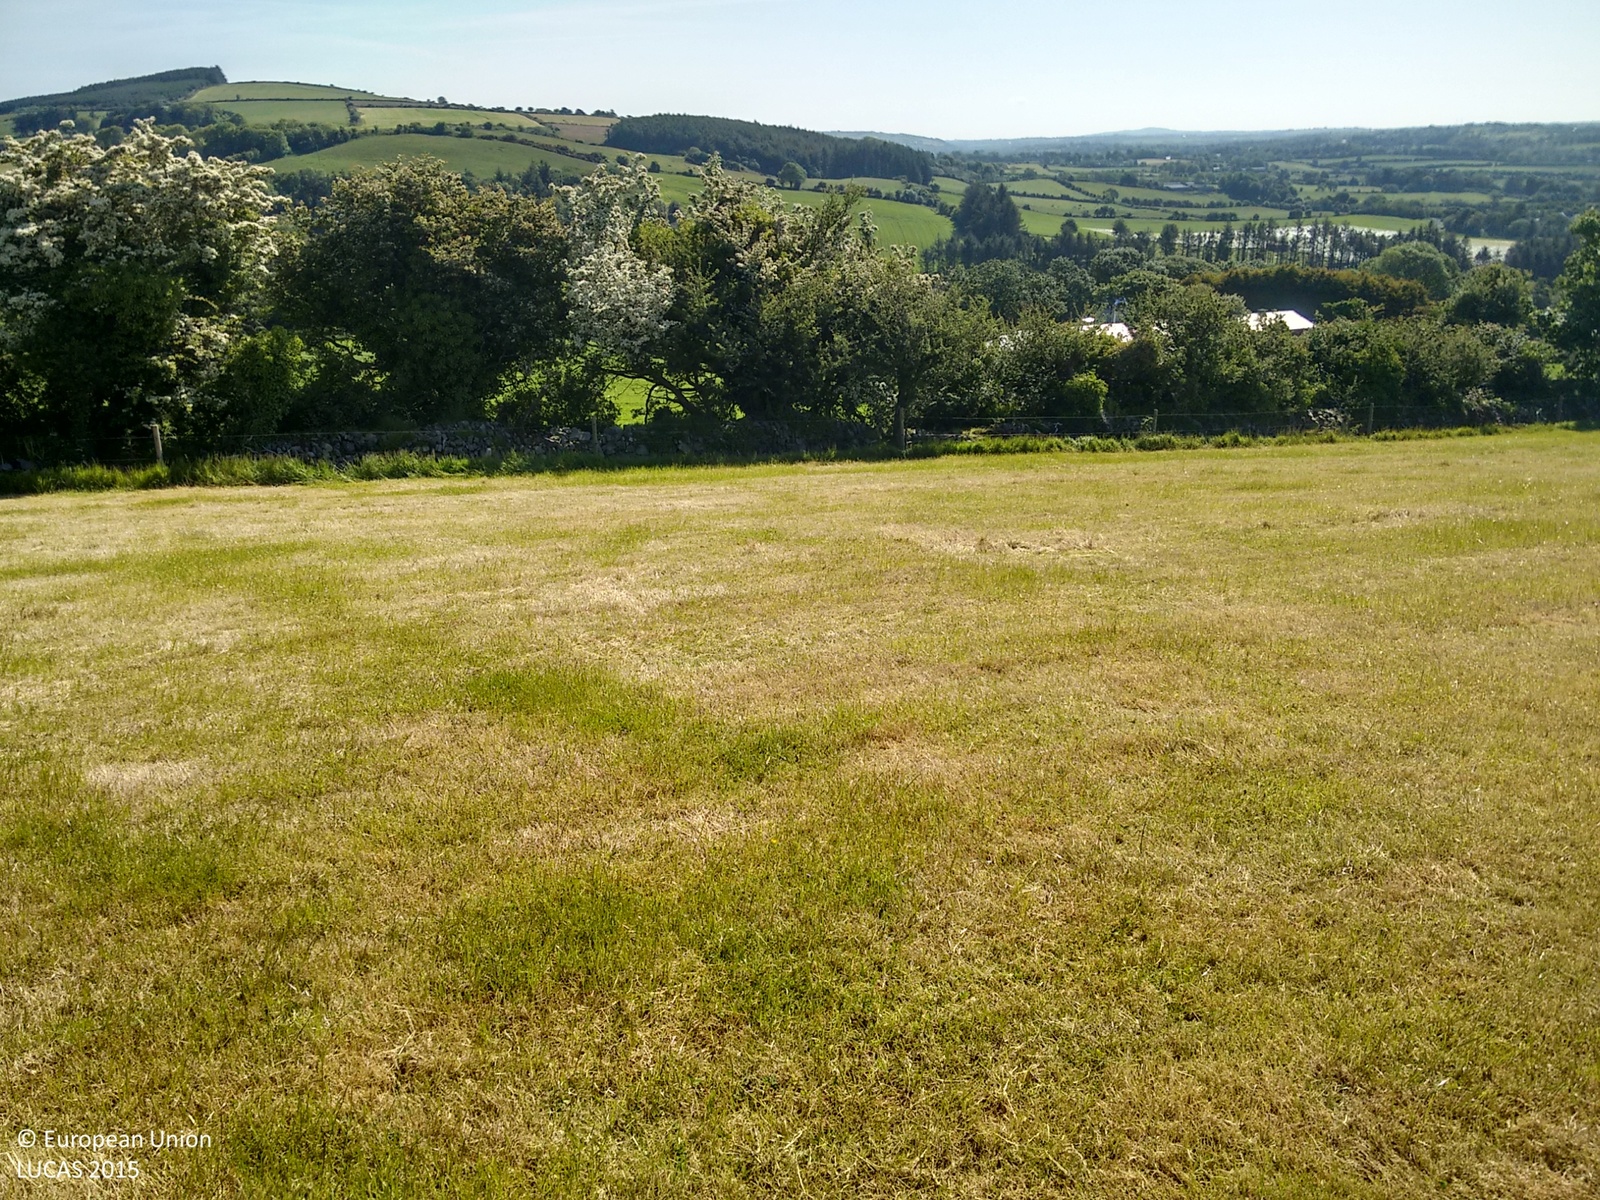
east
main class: Grassland
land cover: Grassland without tree/shrub cover
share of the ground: > 75 %
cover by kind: herbaceous plants 100 %
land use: Agriculture (excluding fallow land and kitchen gardens)
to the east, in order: Grassland without tree/shrub cover; Fences; Broadleaved woodland; Dry stone walls; Grass margins; Barley; Grass margins; Lines of trees; Dry stone walls; Fences; Grassland without tree/shrub cover; Artificial constructions in urban areas
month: June
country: IE
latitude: 51.7929
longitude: -8.7171
